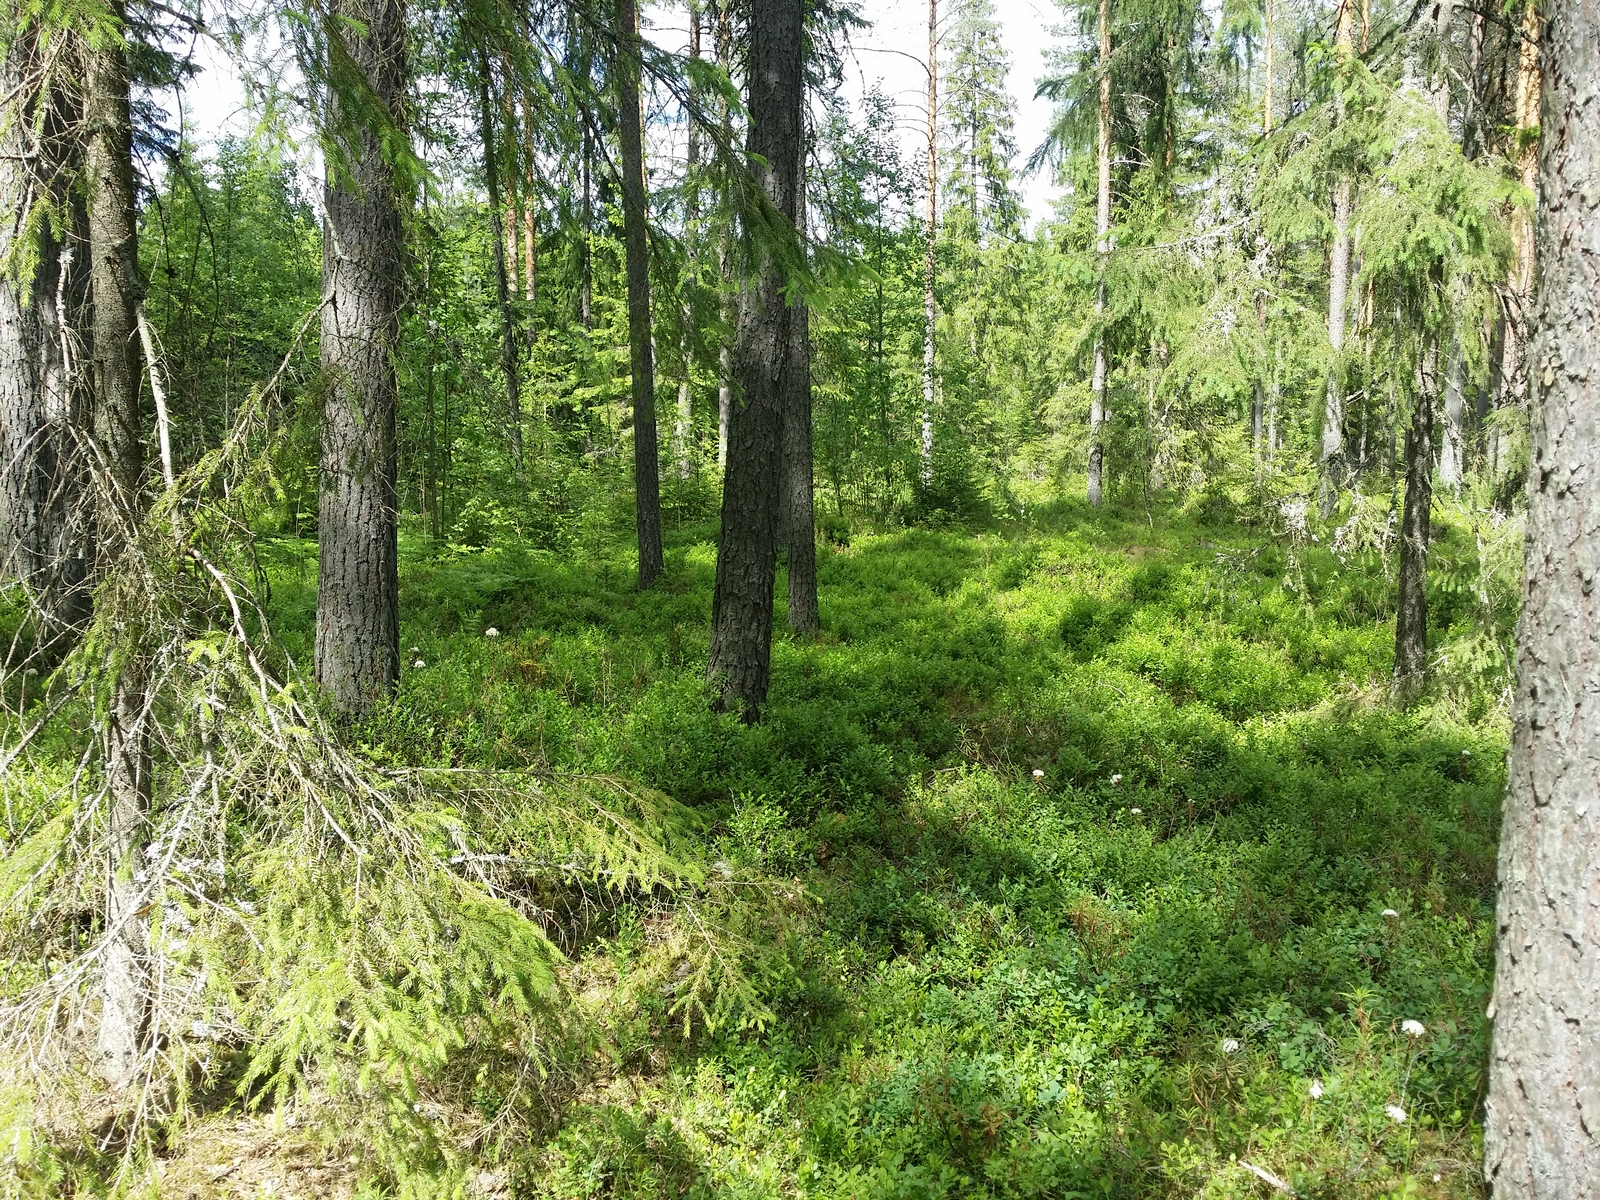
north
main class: Woodland
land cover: Other coniferous woodland
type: hemiboreal forest and nemoral coniferous forest and mixed broadleaved-coniferous forest
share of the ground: 50 - 75 %
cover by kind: coniferous forest trees 65 %, lichens and mosses 25 %, herbaceous plants 10 %
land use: Forestry
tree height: > 5 m
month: June
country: LV
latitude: 57.2869
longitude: 26.4509
